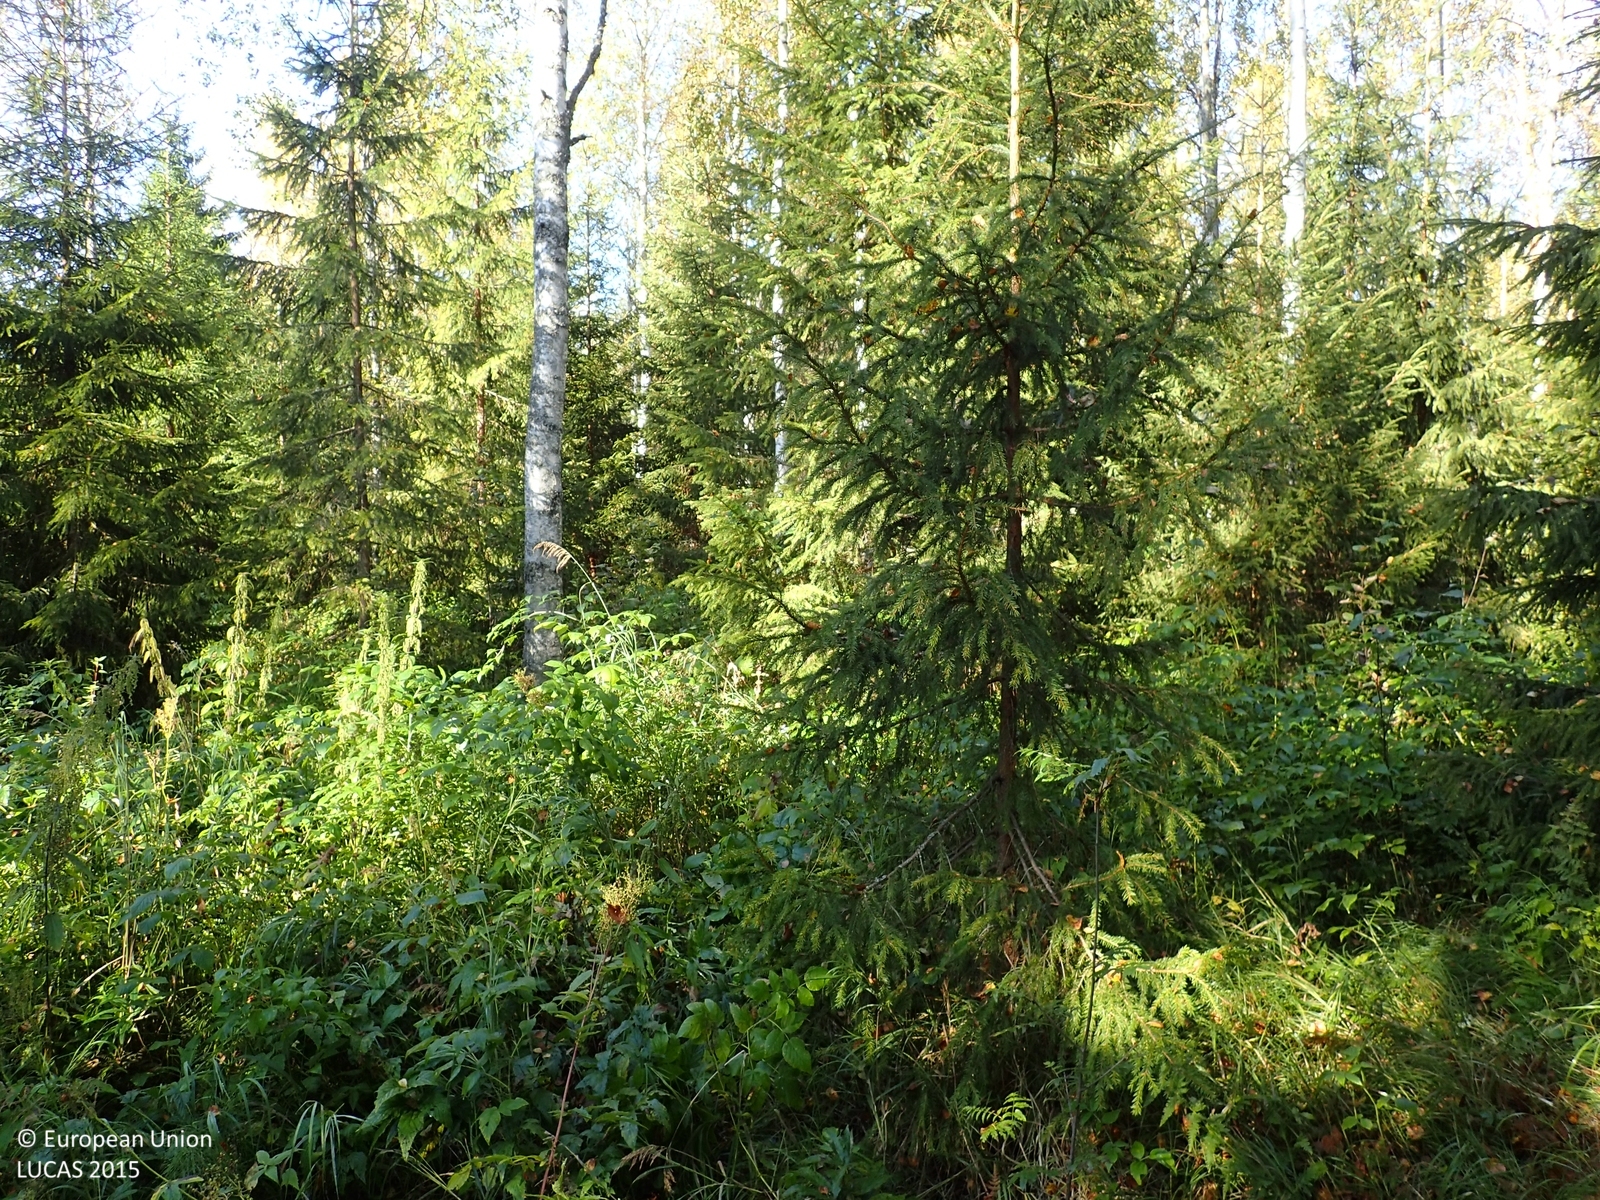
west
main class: Woodland
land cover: Spruce dominated mixed woodland
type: boreal forest
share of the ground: > 75 %
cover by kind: broadleaved forest trees 55 %, herbaceous plants 25 %, coniferous forest trees 20 %
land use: Forestry
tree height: > 5 m
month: September
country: FI
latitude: 63.1102
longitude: 25.3422
